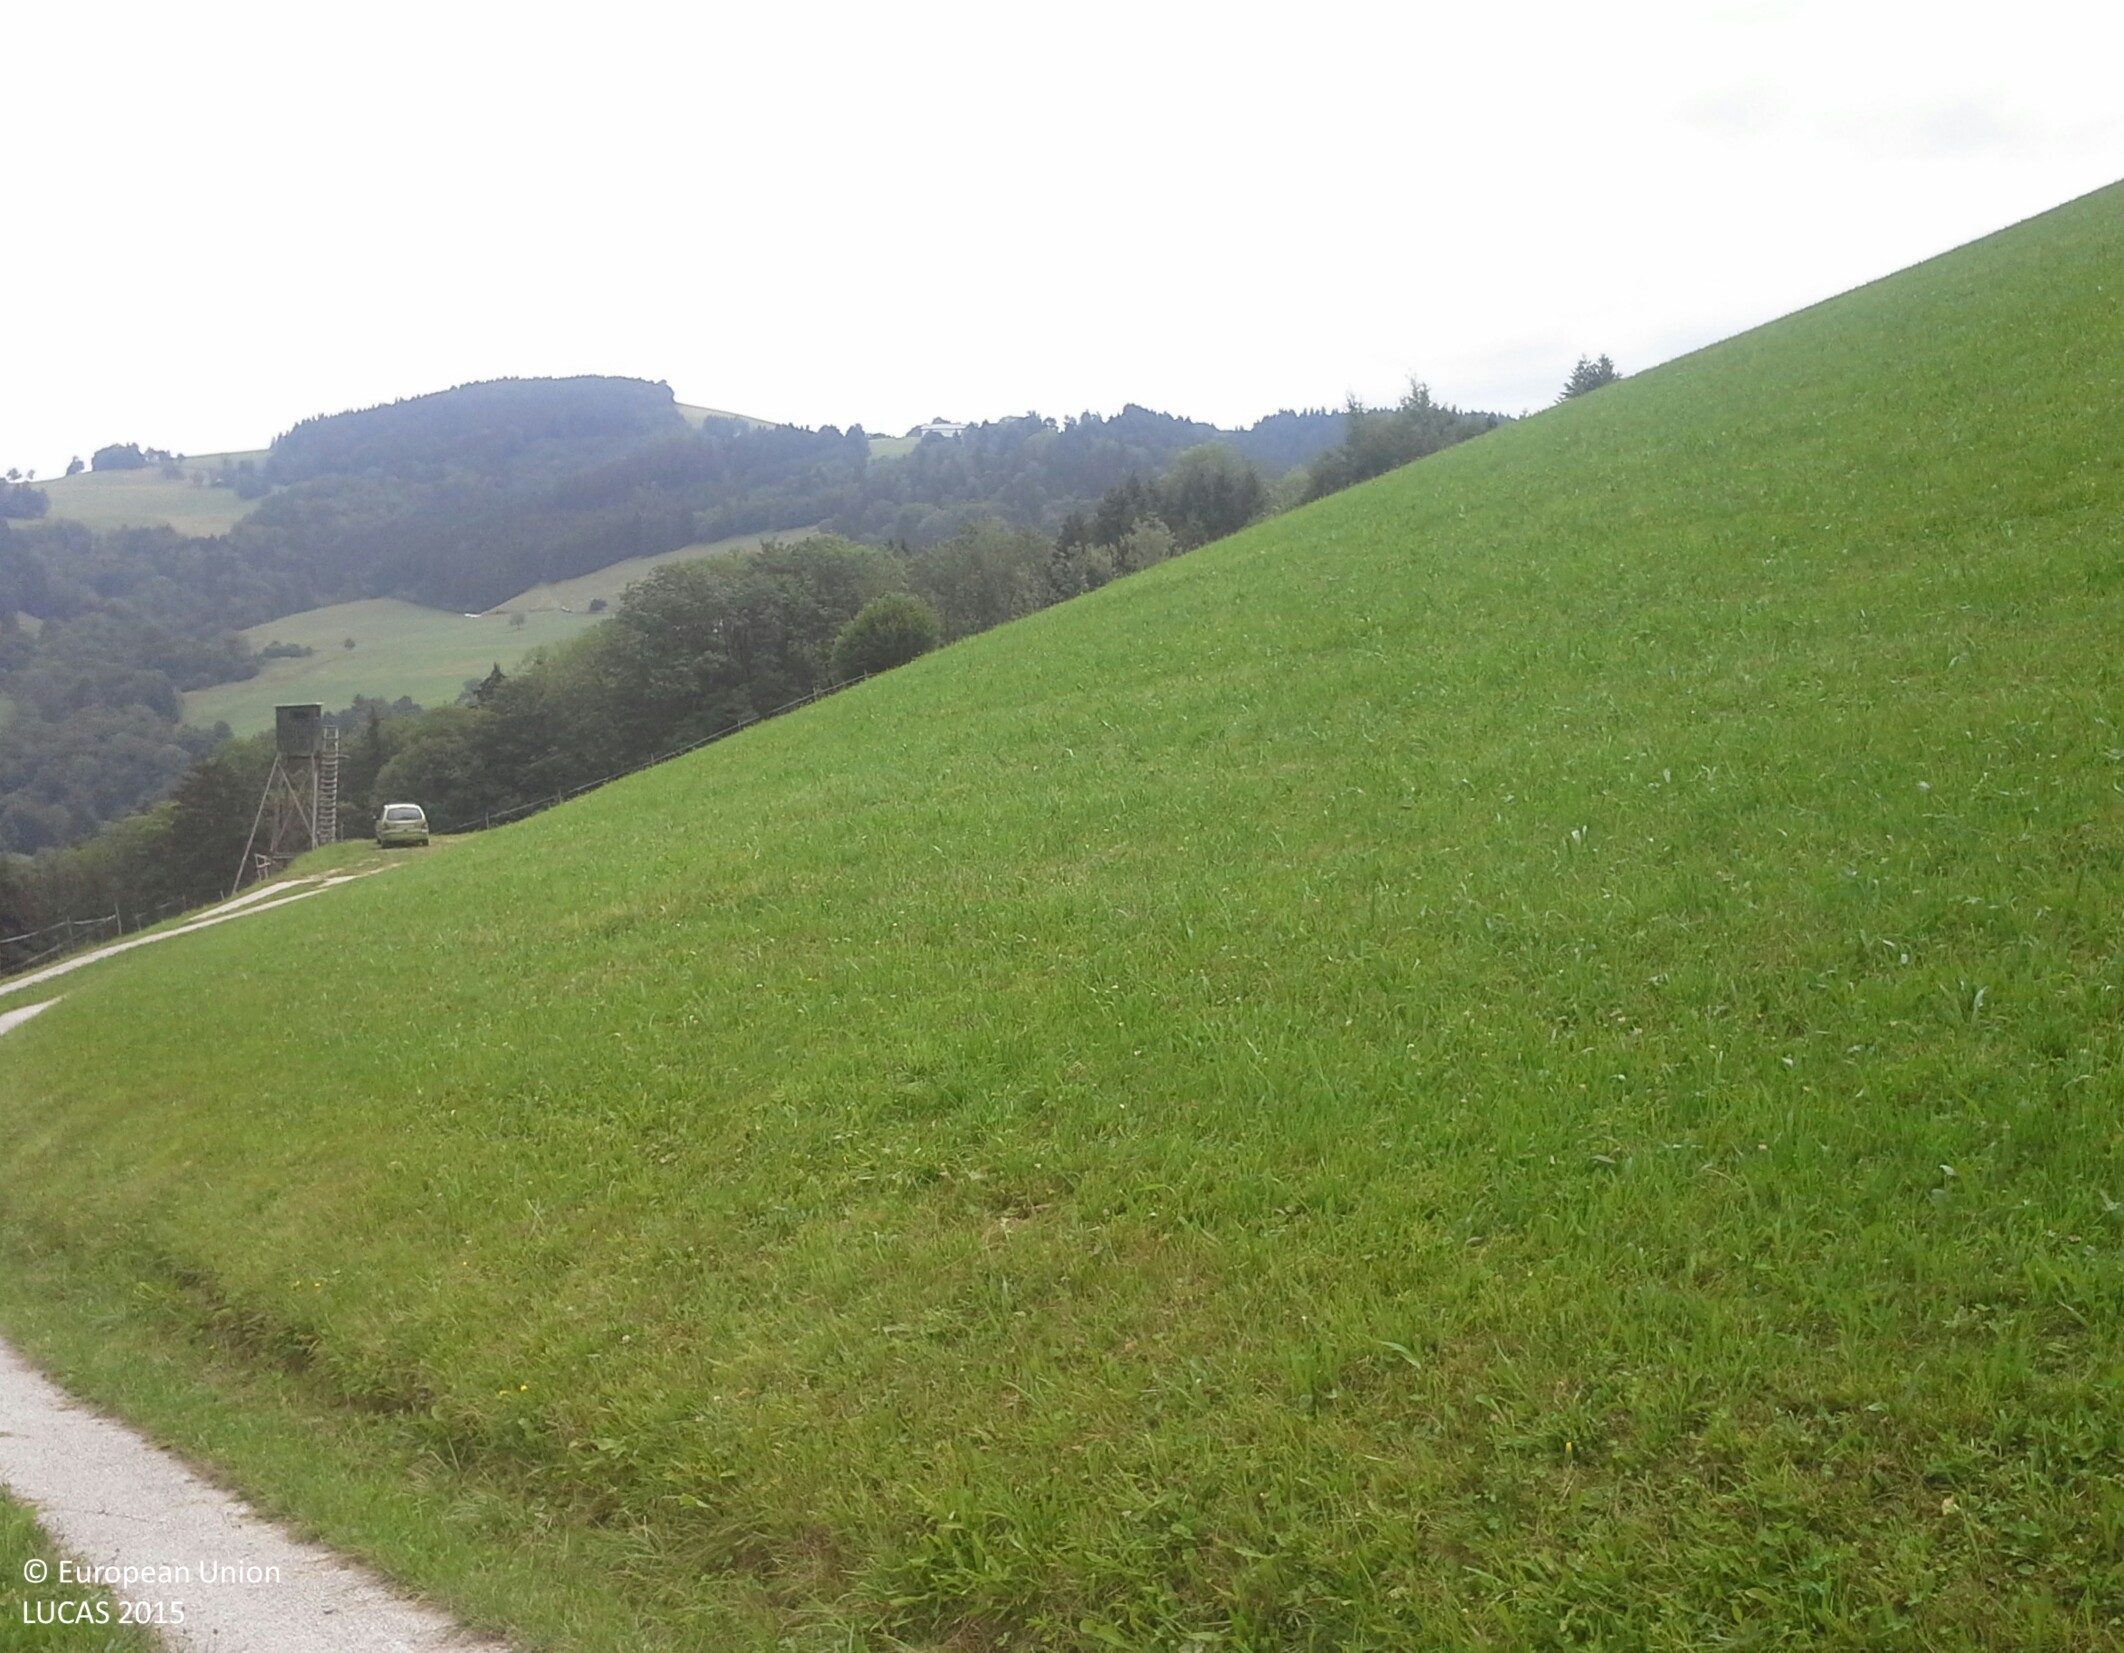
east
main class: Grassland
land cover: Grassland without tree/shrub cover
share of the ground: > 75 %
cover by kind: herbaceous plants 100 %
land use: Agriculture (excluding fallow land and kitchen gardens)
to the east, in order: Grassland without tree/shrub cover; Fences; Tracks; Grassland without tree/shrub cover; Tracks; Fences; Grassland without tree/shrub cover; Fences; Grassland without tree/shrub cover; Single bushes/trees; Grassland without tree/shrub cover; Fences; Broadleaved woodland
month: July
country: AT
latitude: 48.0187
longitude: 15.0287
